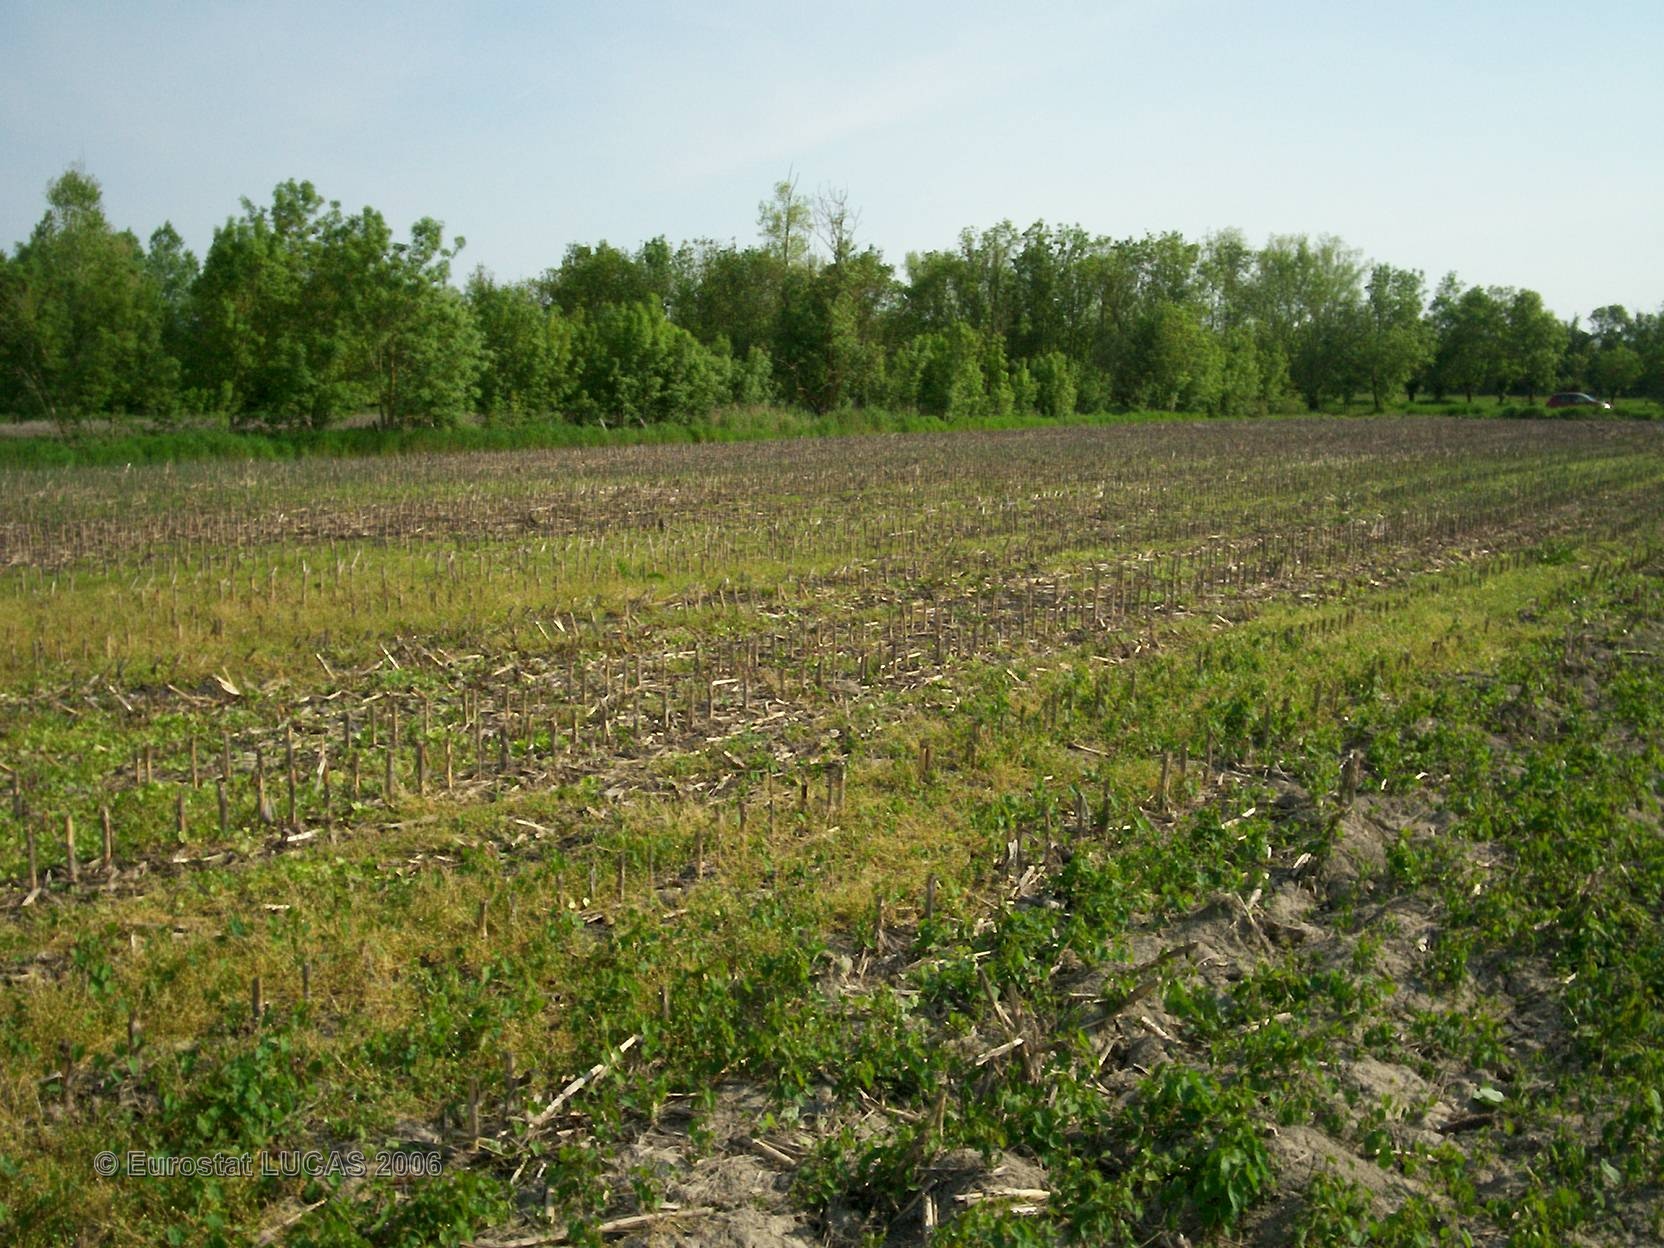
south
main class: Cropland
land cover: Maize
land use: Agriculture (excluding fallow land and kitchen gardens)
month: May
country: FR
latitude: 46.2460
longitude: -0.7279
